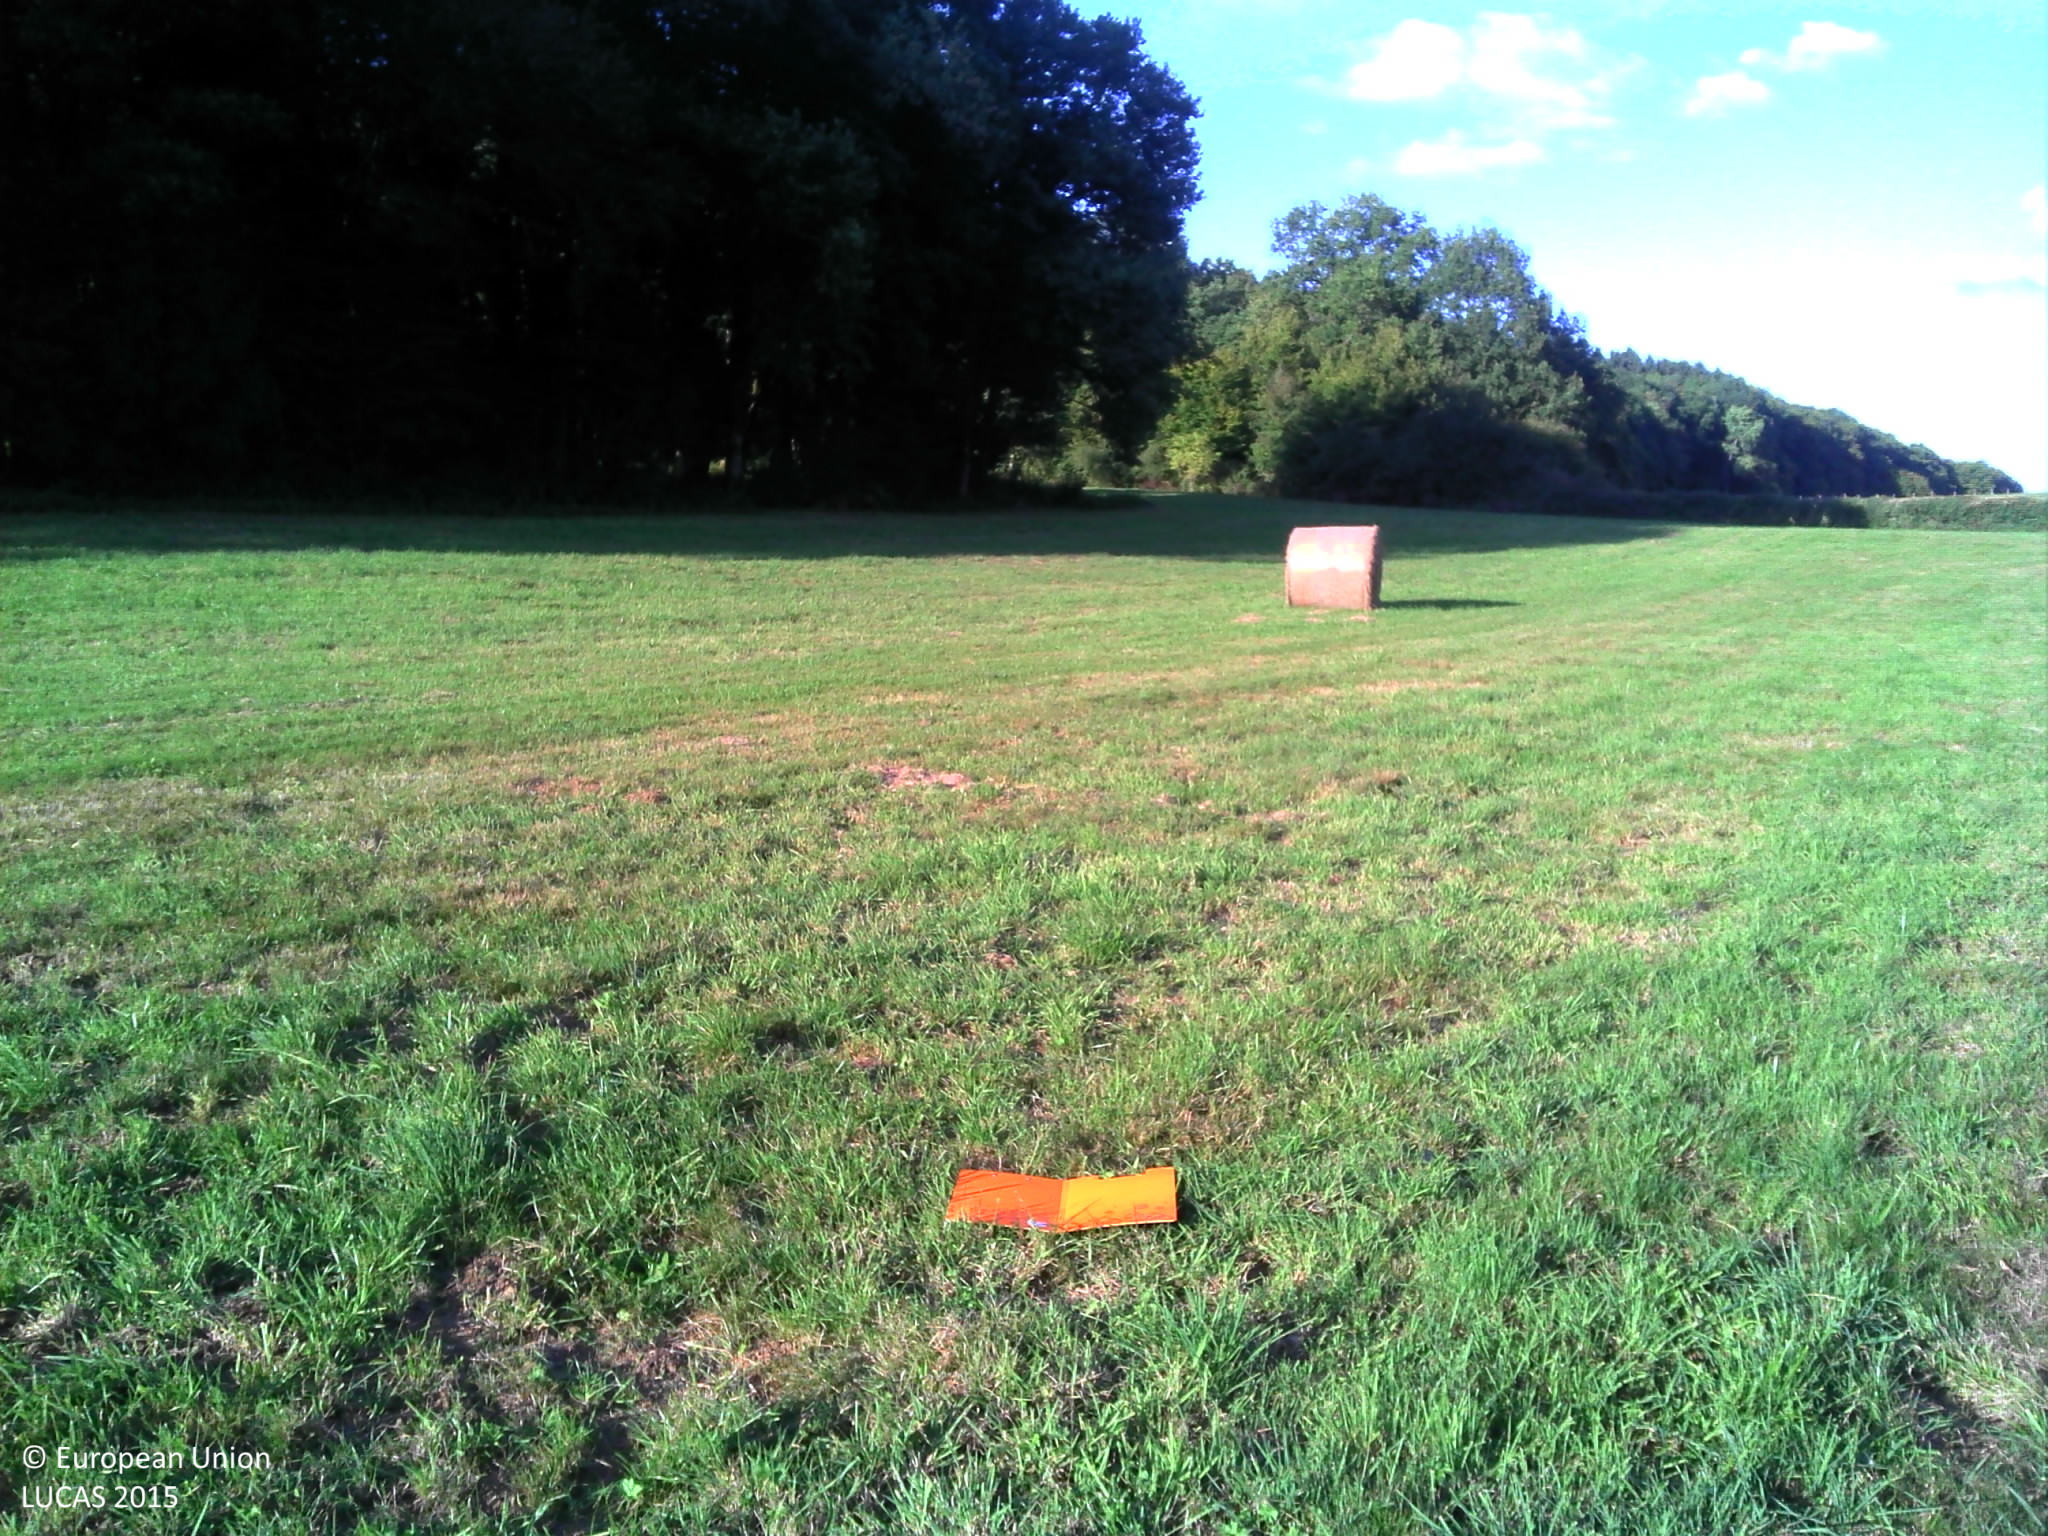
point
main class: Grassland
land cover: Grassland without tree/shrub cover
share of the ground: > 75 %
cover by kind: herbaceous plants 100 %
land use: Agriculture (excluding fallow land and kitchen gardens)
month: September
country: FR
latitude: 47.2953
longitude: 6.2594
